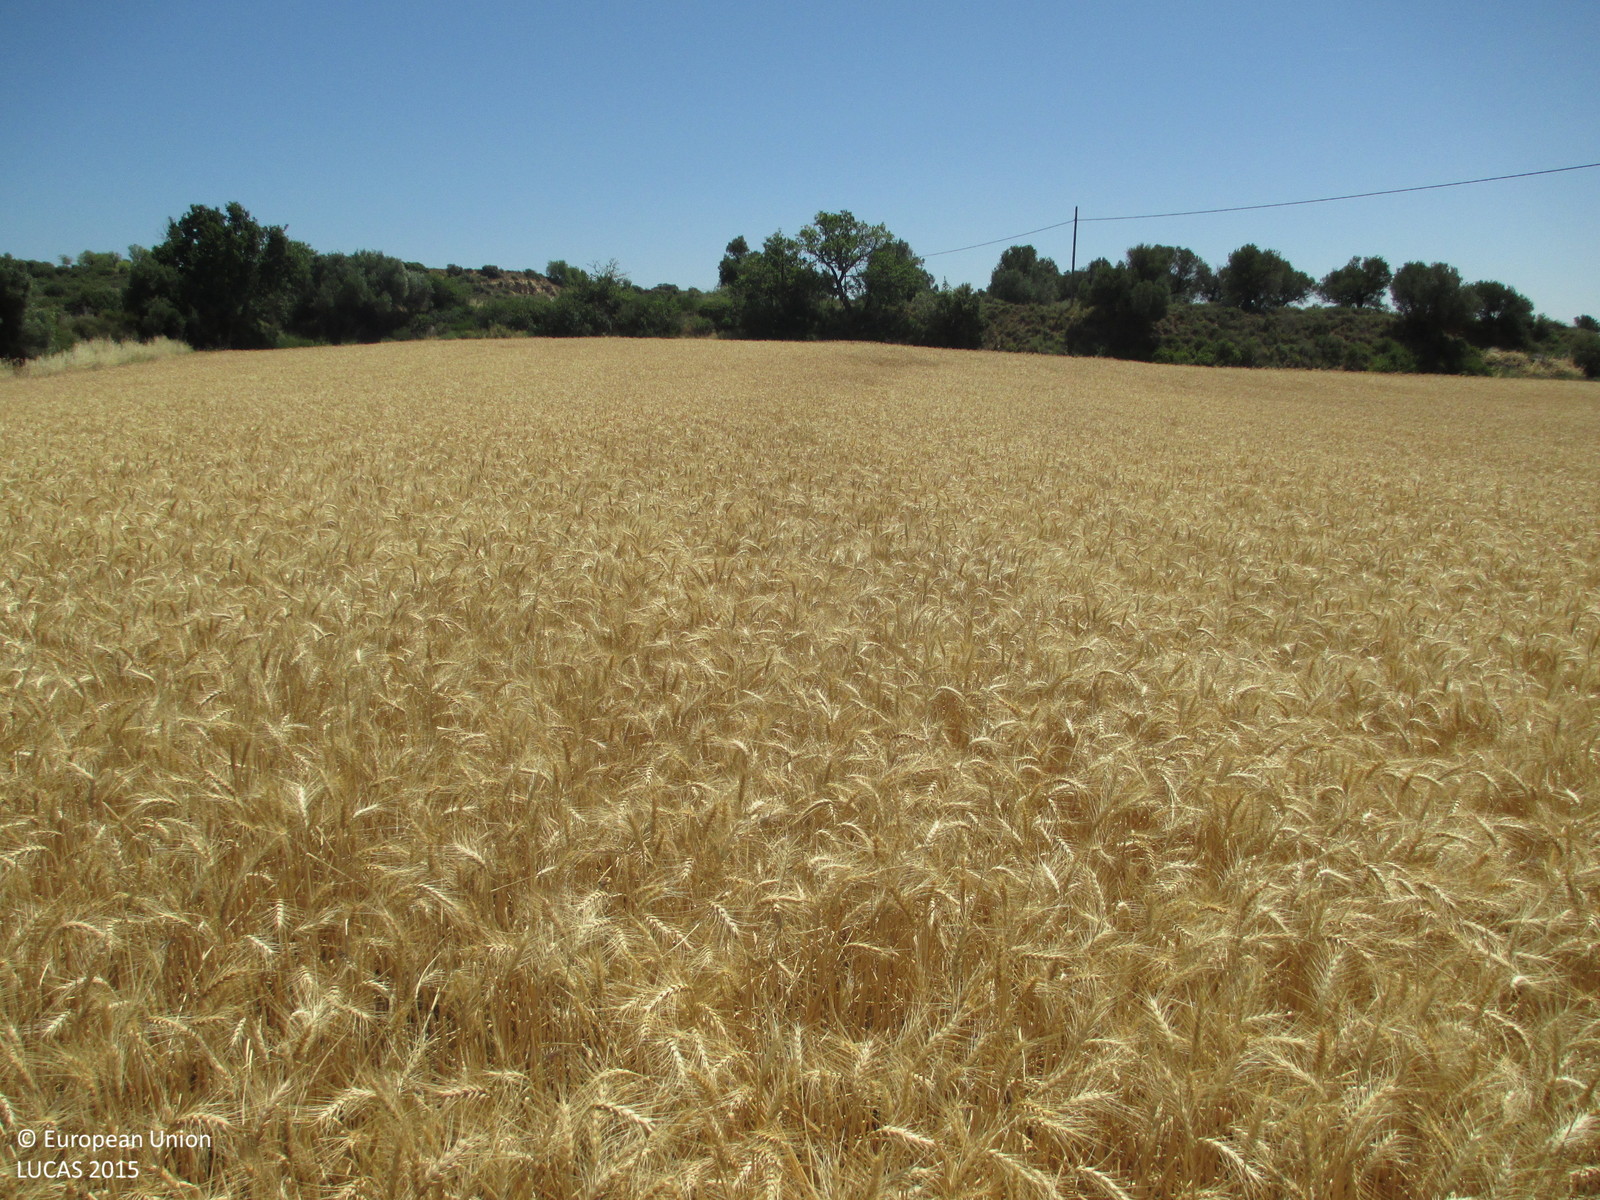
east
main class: Cropland
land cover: Durum wheat
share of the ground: > 75 %
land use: Agriculture (excluding fallow land and kitchen gardens)
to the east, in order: Durum wheat; Single bushes/trees; Shruby margins; Olive groves; Electric lines; Olive groves; Shrubland with sparse tree cover; Rivers and streams; Shrubland without tree cover; Tracks
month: June
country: ES
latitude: 42.1999
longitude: -0.3044
